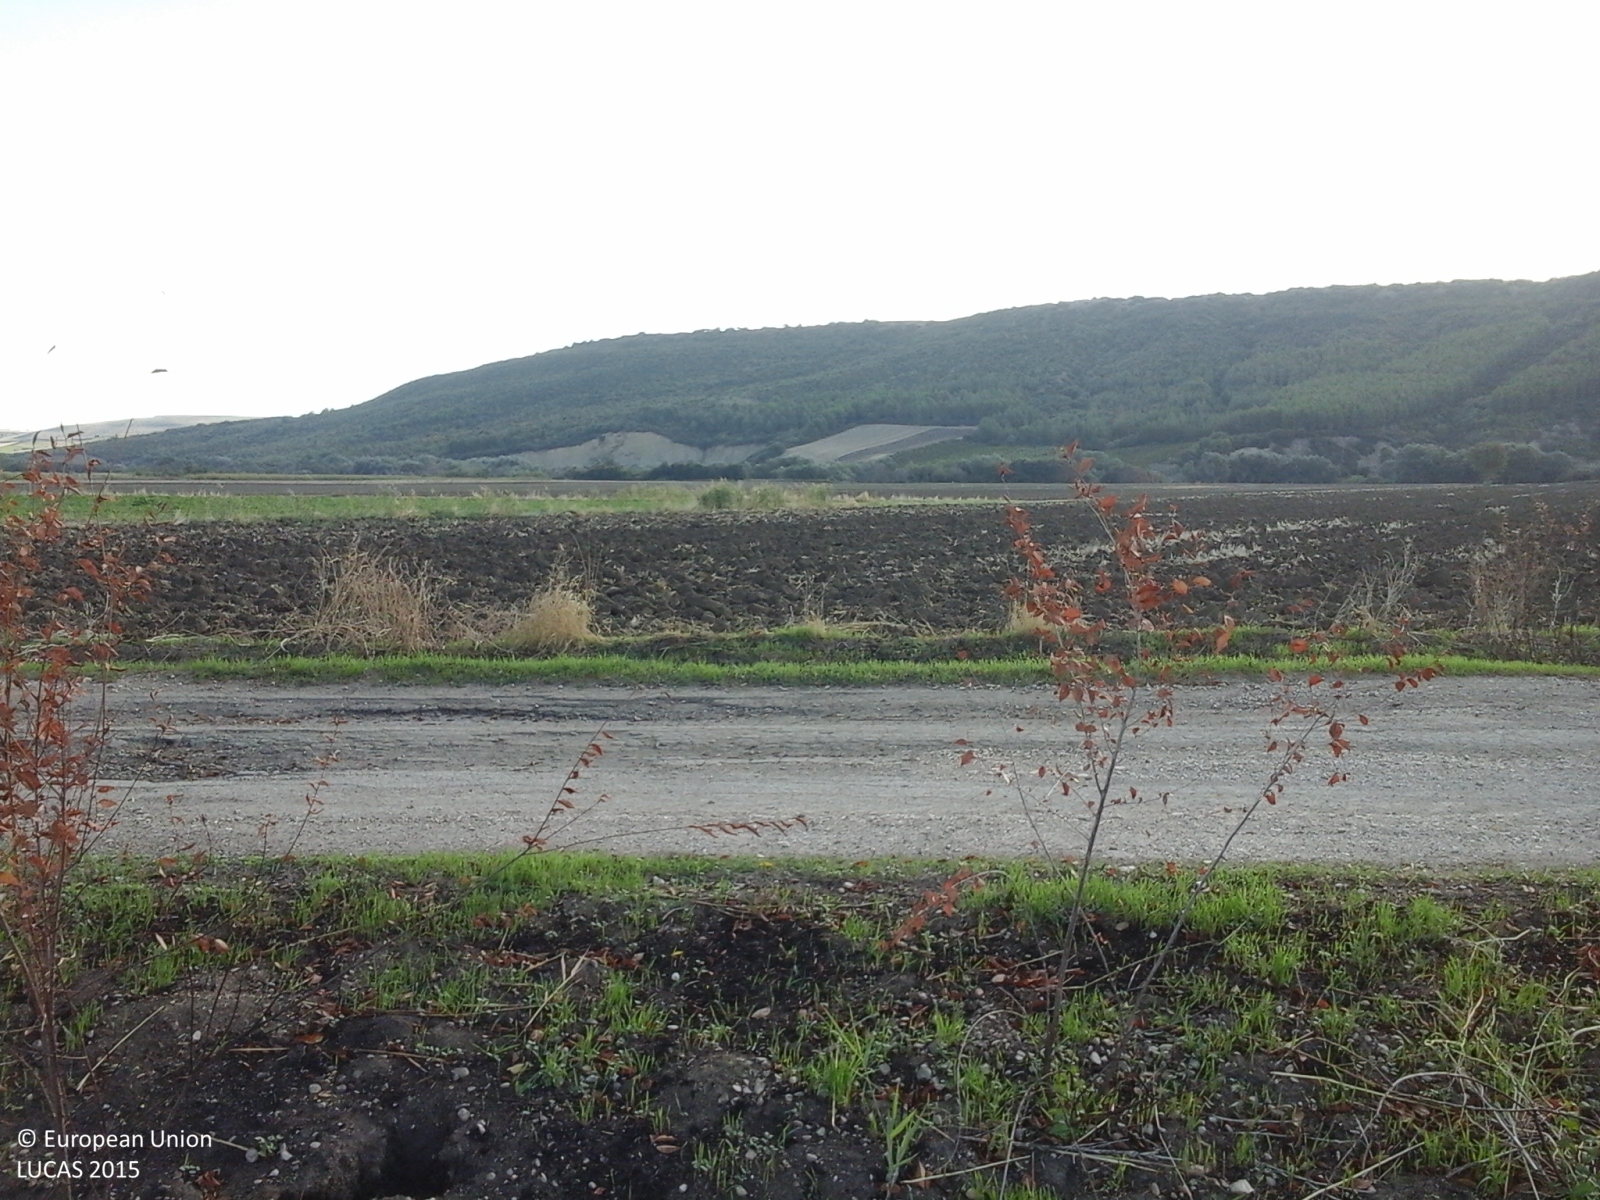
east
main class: Cropland
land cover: Durum wheat
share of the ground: > 75 %
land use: Agriculture (excluding fallow land and kitchen gardens)
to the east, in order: Durum wheat; Grass margins; Paved roads, cycling and walking lanes; Abandoned hedges; Durum wheat; Sunflower
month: October
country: IT
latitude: 41.7955
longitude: 15.2187
